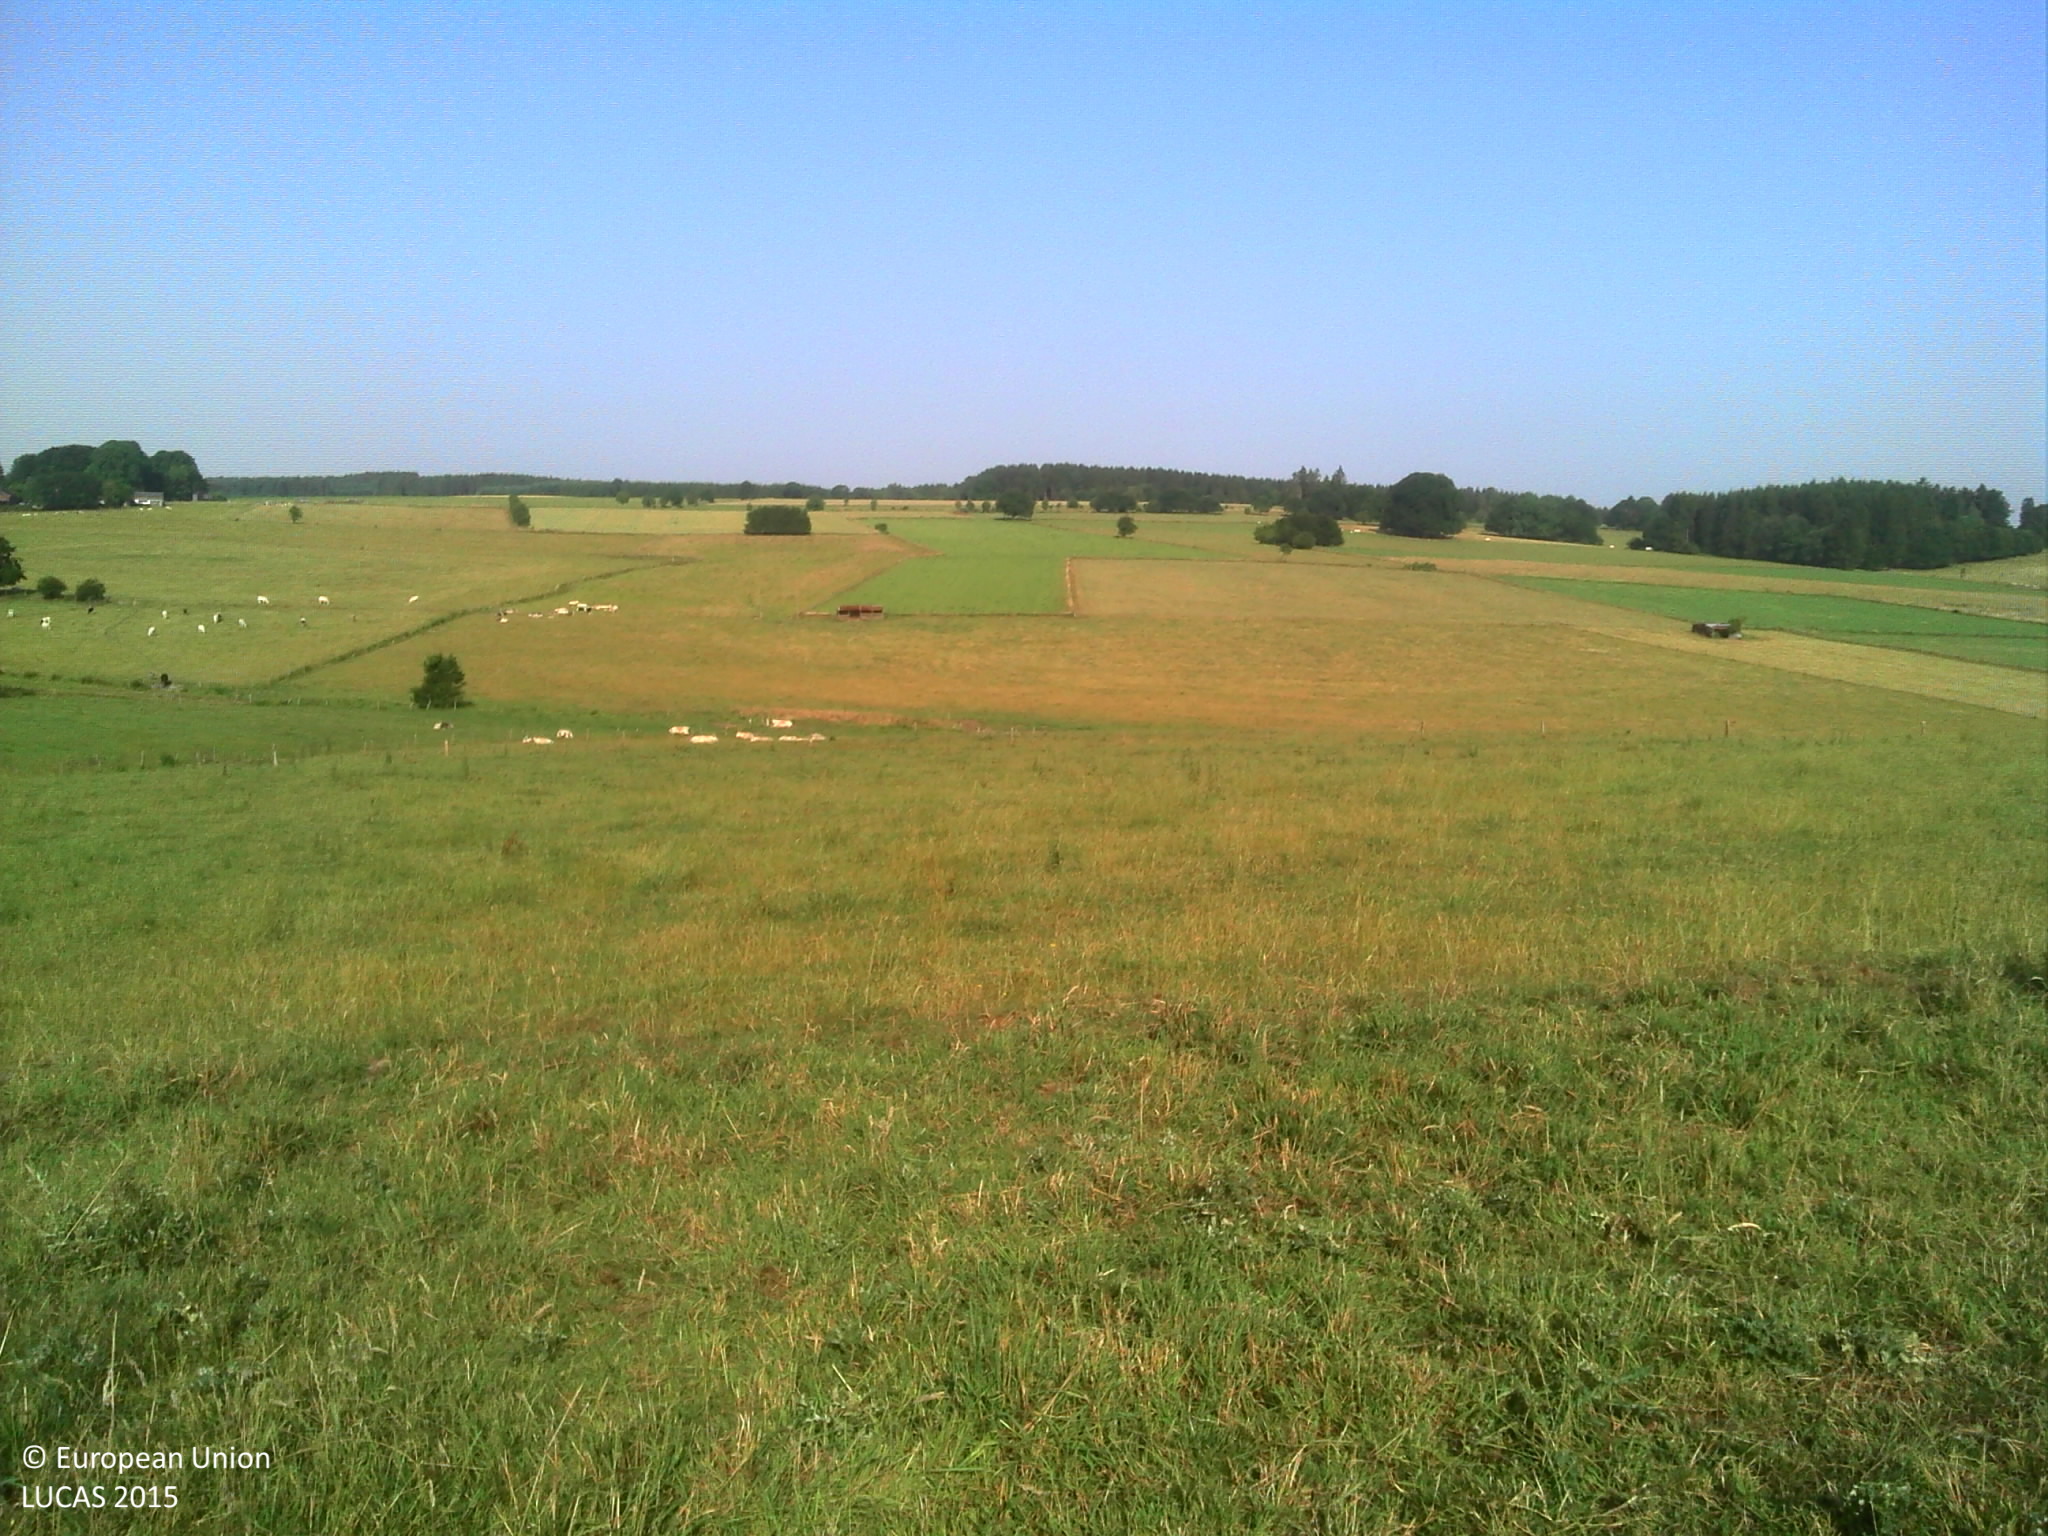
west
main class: Grassland
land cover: Grassland without tree/shrub cover
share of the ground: > 75 %
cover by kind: herbaceous plants 100 %
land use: Agriculture (excluding fallow land and kitchen gardens)
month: July
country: BE
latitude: 49.9545
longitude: 5.5802
